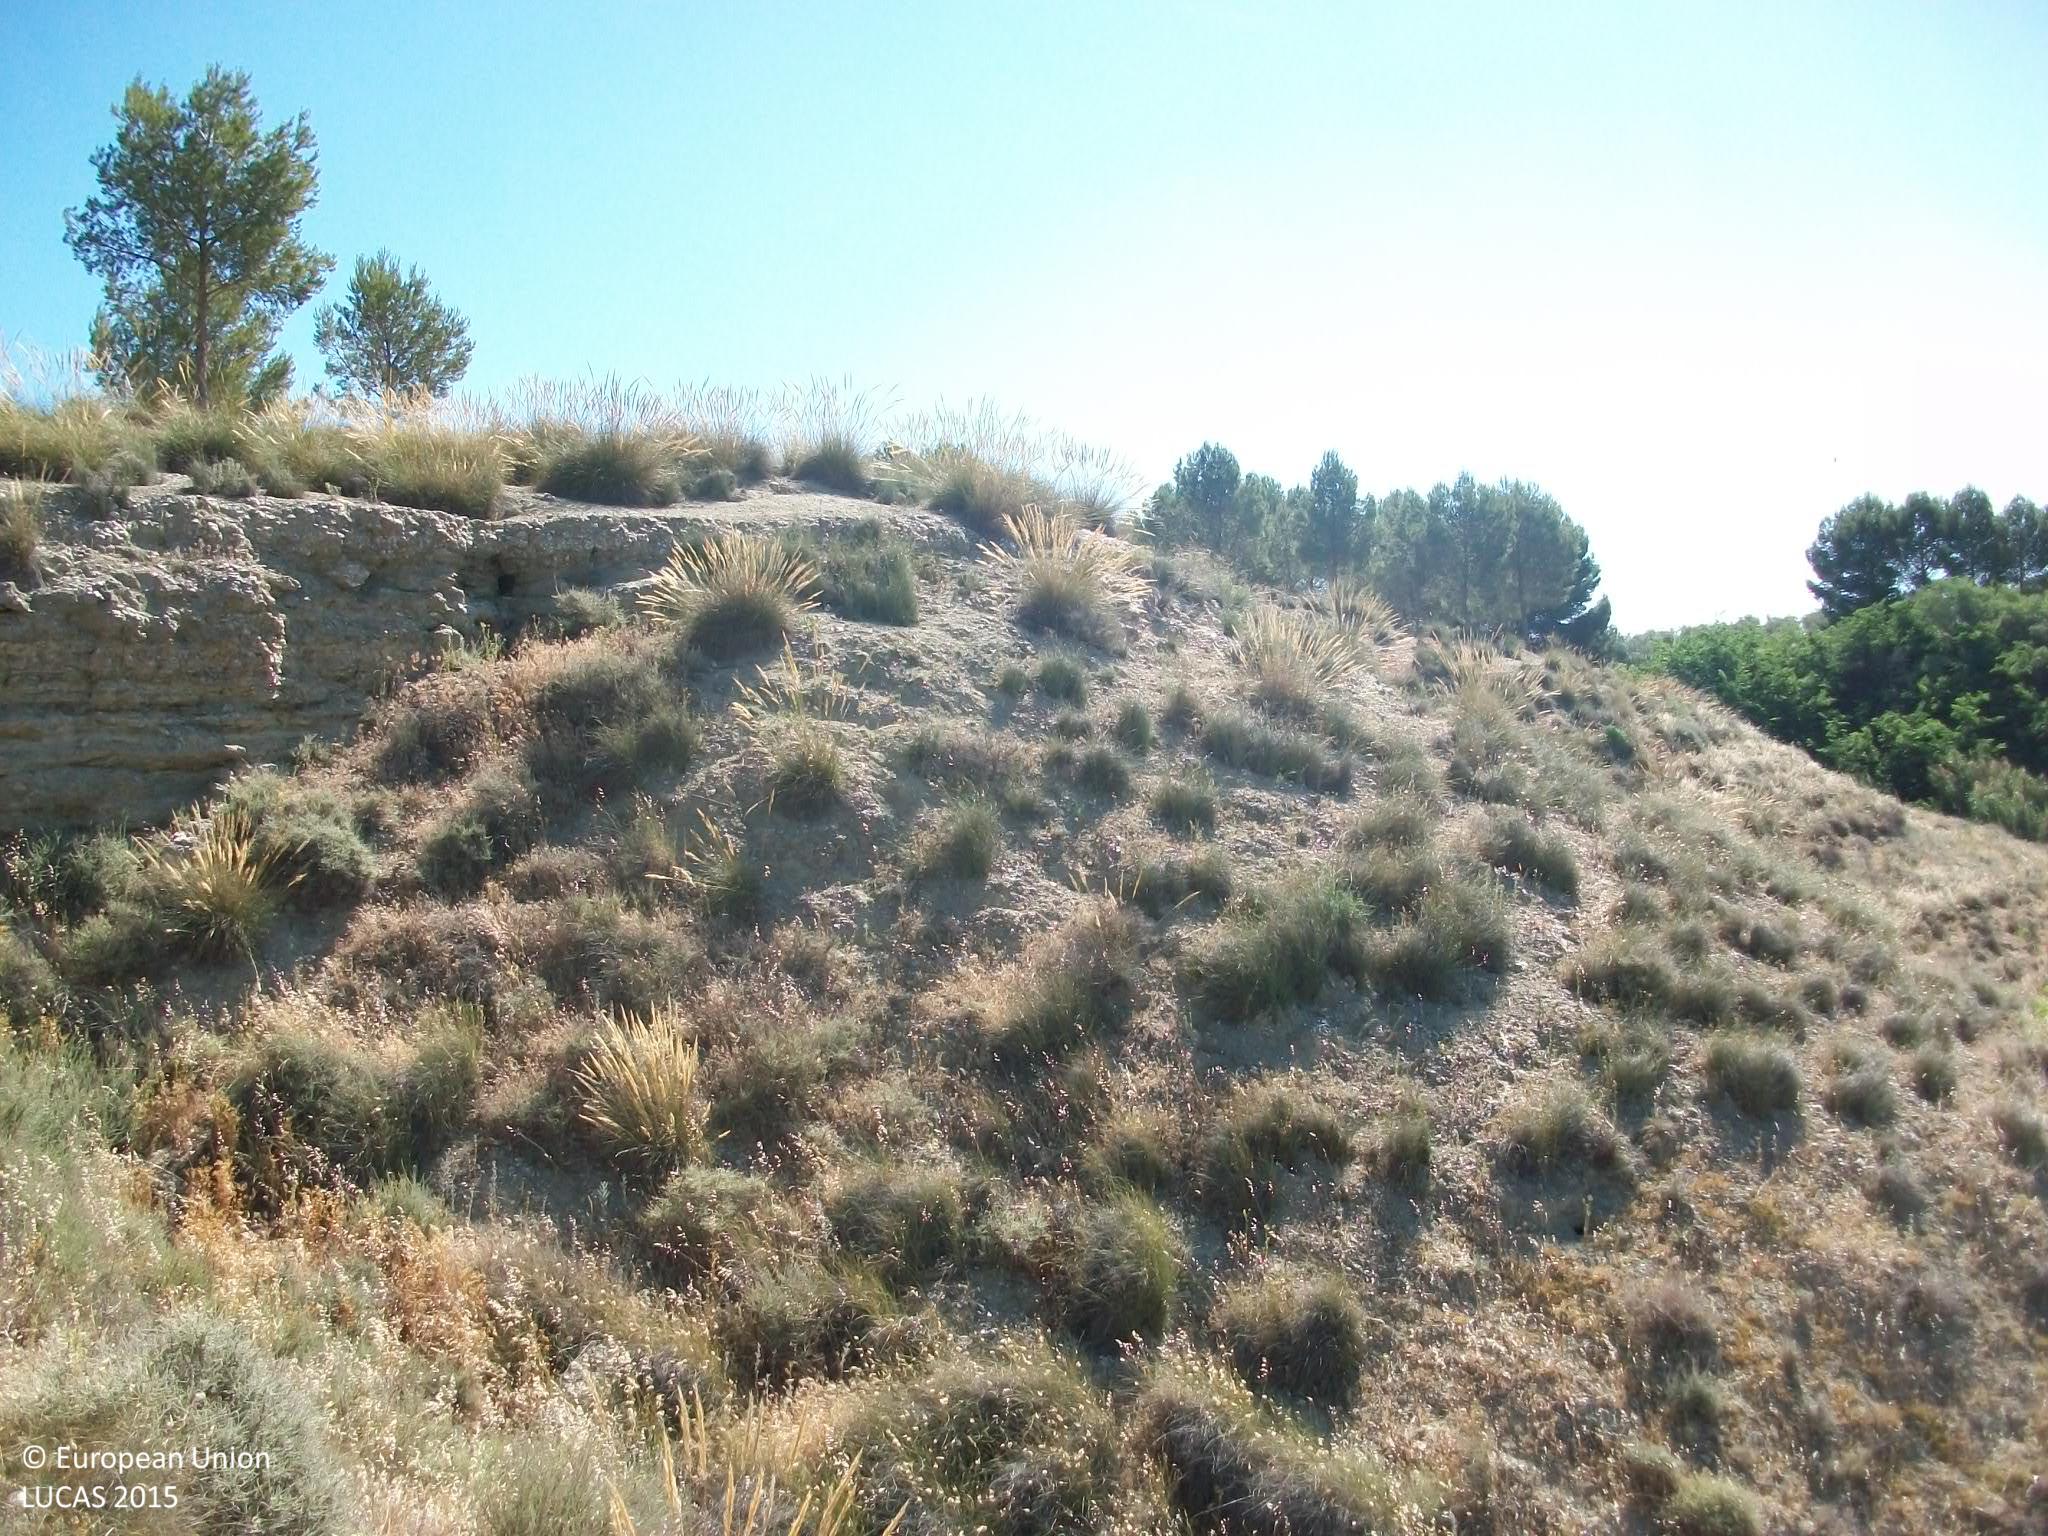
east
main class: Grassland
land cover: Grassland without tree/shrub cover
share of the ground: > 75 %
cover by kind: herbaceous plants 80 %, consolidated bare surface 20 %
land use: Semi-natural and natural areas not in use
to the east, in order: Grassland without tree/shrub cover; Pine dominated coniferous woodland; Tracks; Pine dominated coniferous woodland; Olive groves
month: May
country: ES
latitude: 39.8729
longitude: -3.6741
